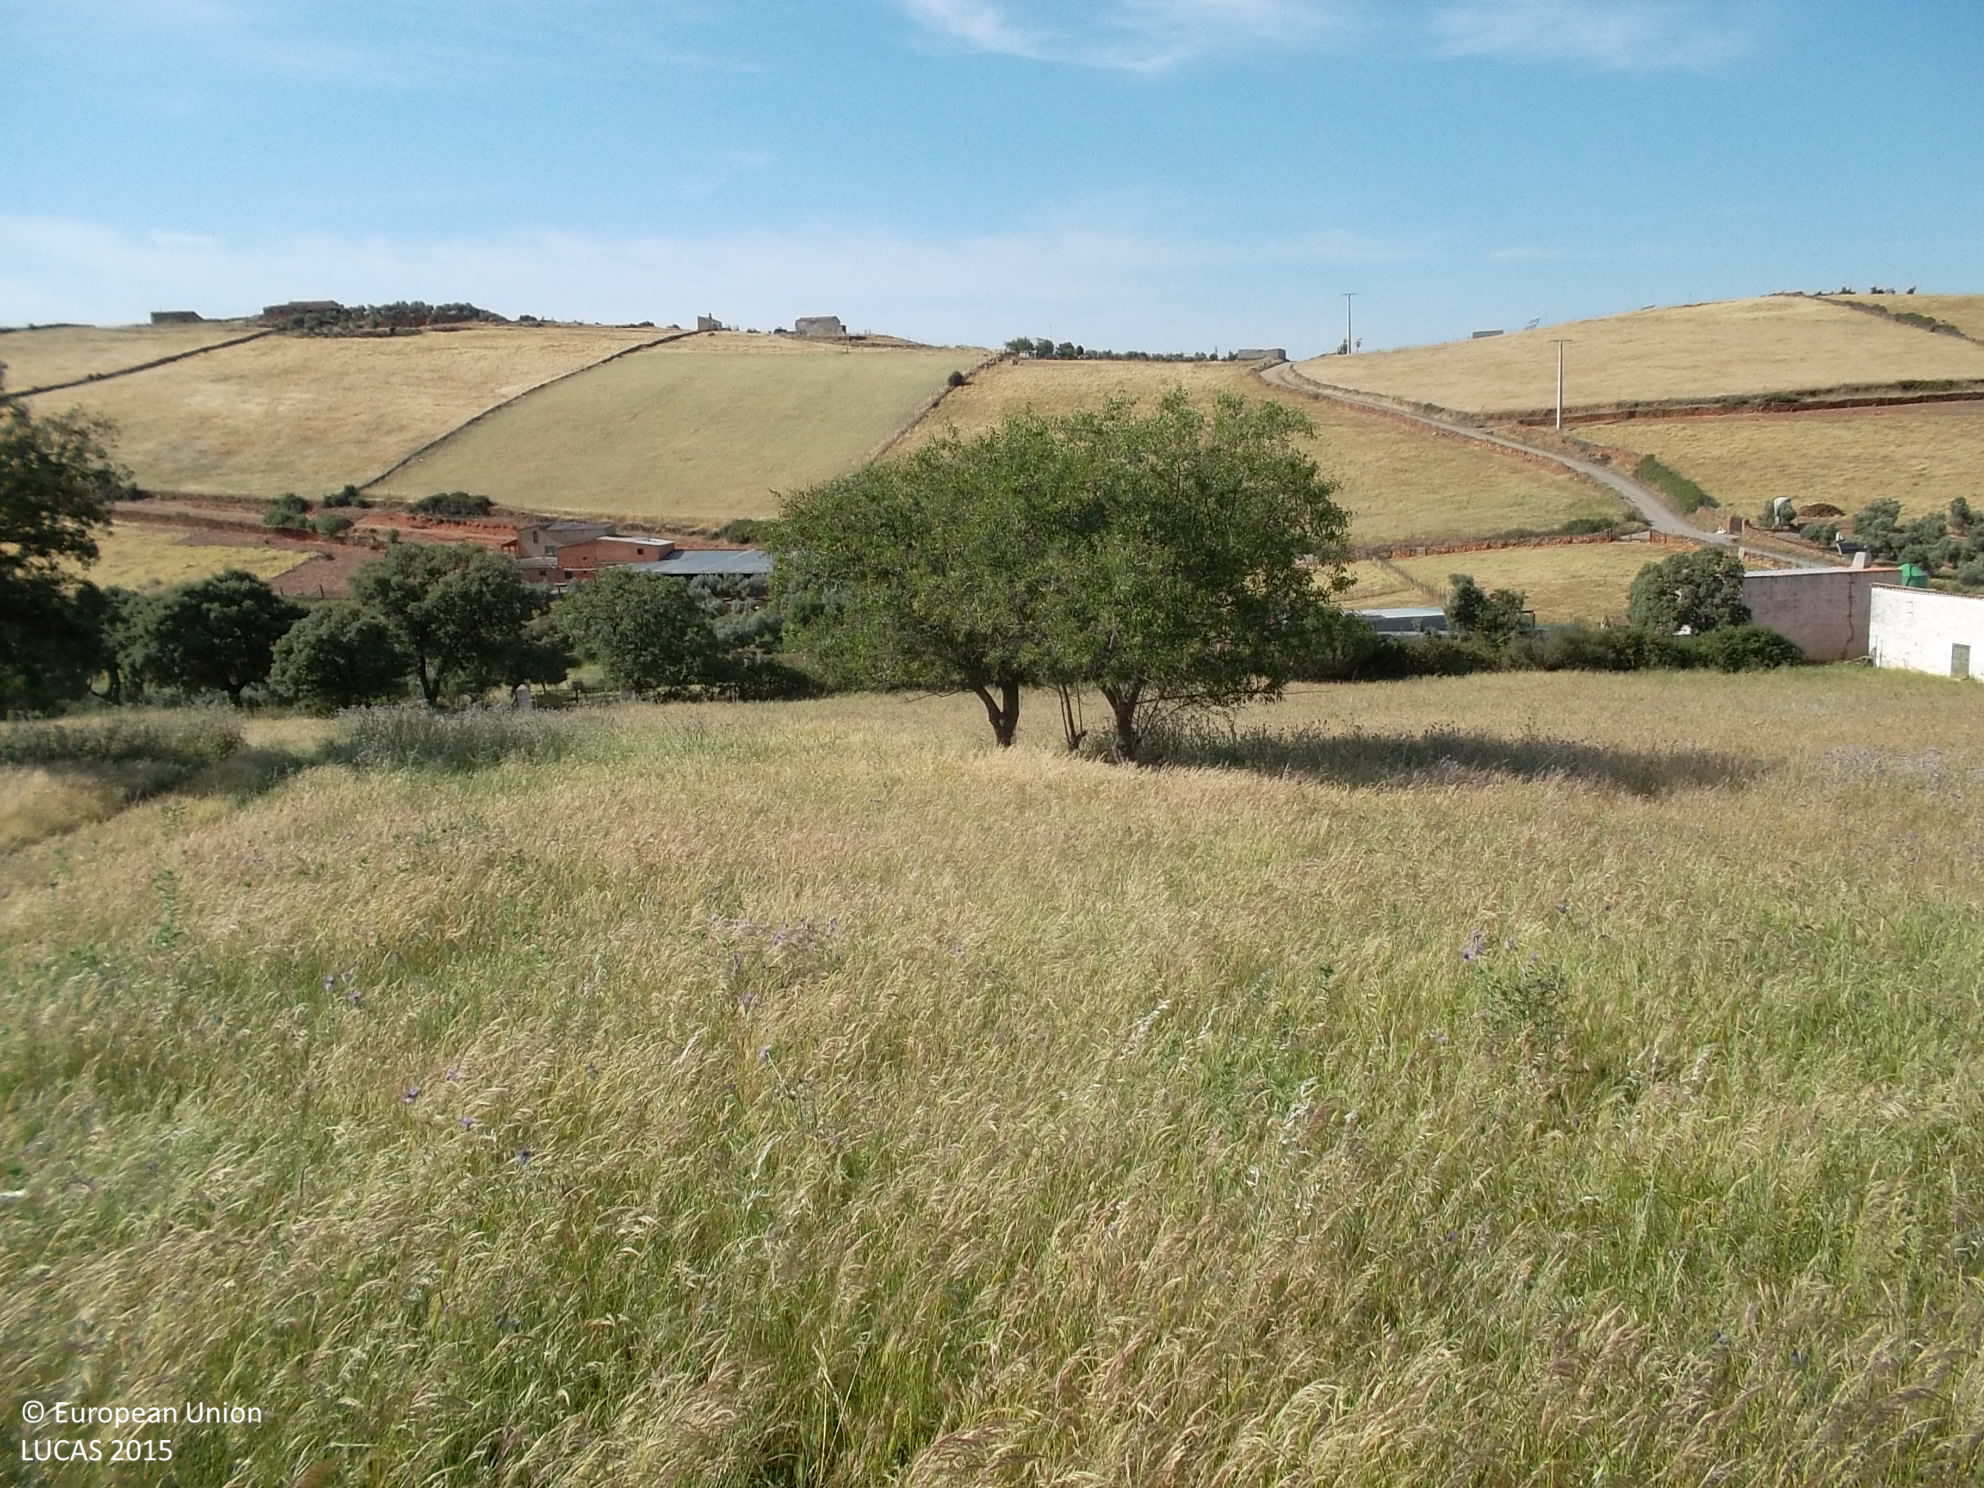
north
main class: Grassland
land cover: Grassland without tree/shrub cover
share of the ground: > 75 %
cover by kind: herbaceous plants 100 %
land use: Agriculture (excluding fallow land and kitchen gardens)
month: May
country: ES
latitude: 38.7677
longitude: -4.8185
